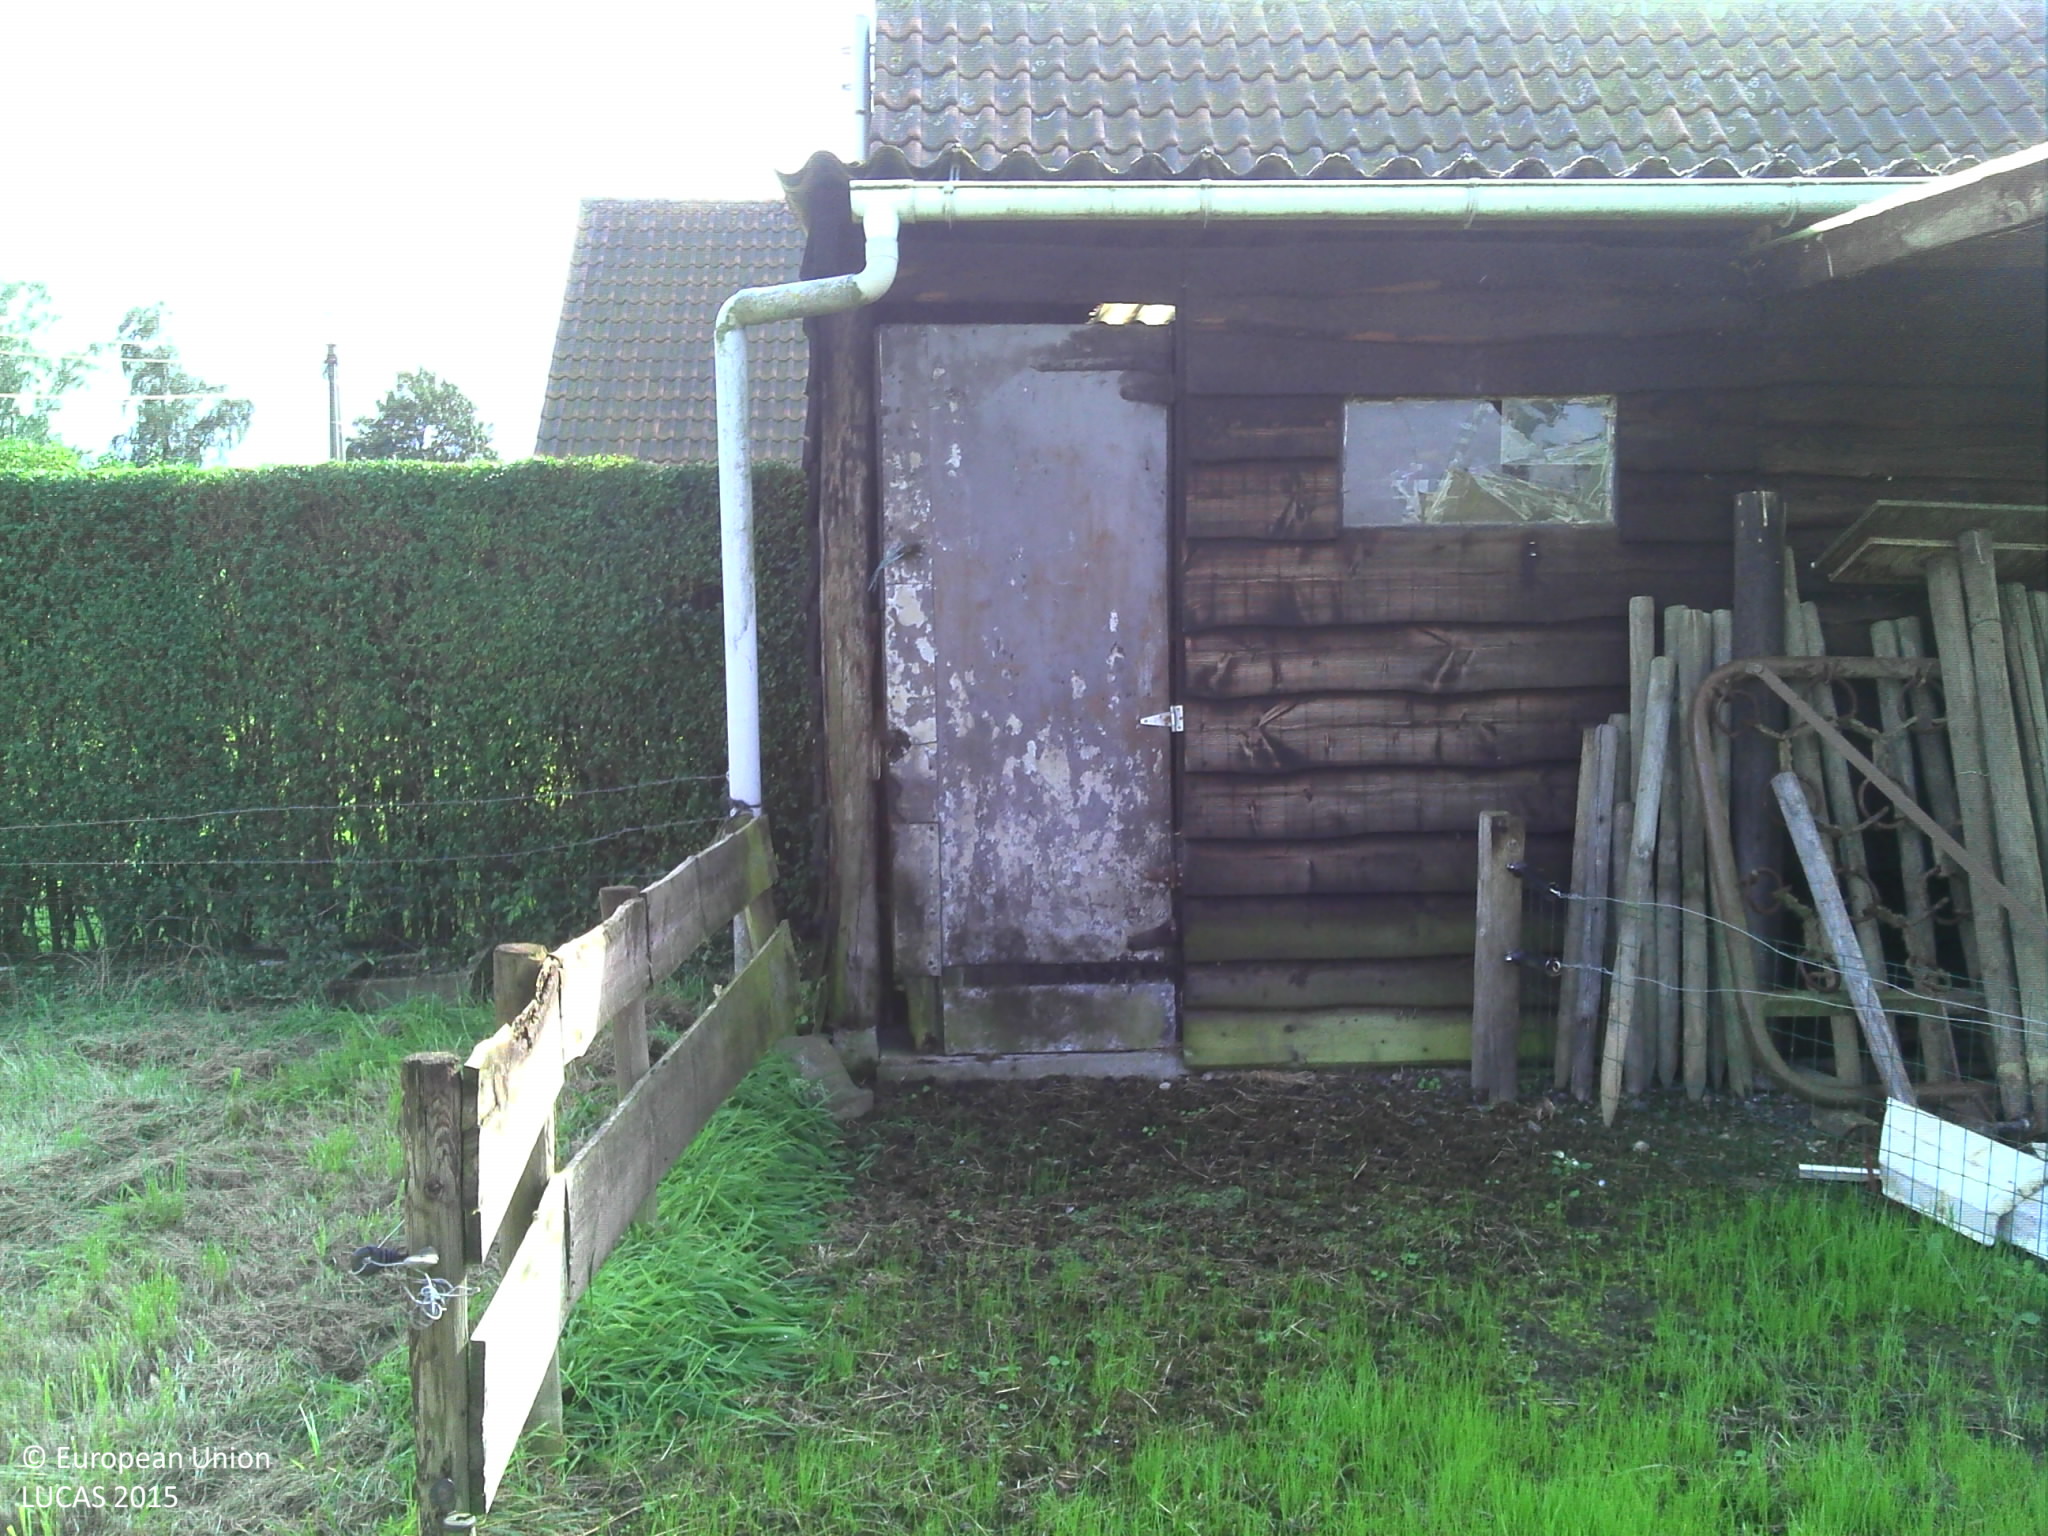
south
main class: Grassland
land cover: Grassland without tree/shrub cover
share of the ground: > 75 %
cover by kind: herbaceous plants 100 %
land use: Agriculture (excluding fallow land and kitchen gardens)
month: September
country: BE
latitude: 51.1877
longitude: 4.5160
